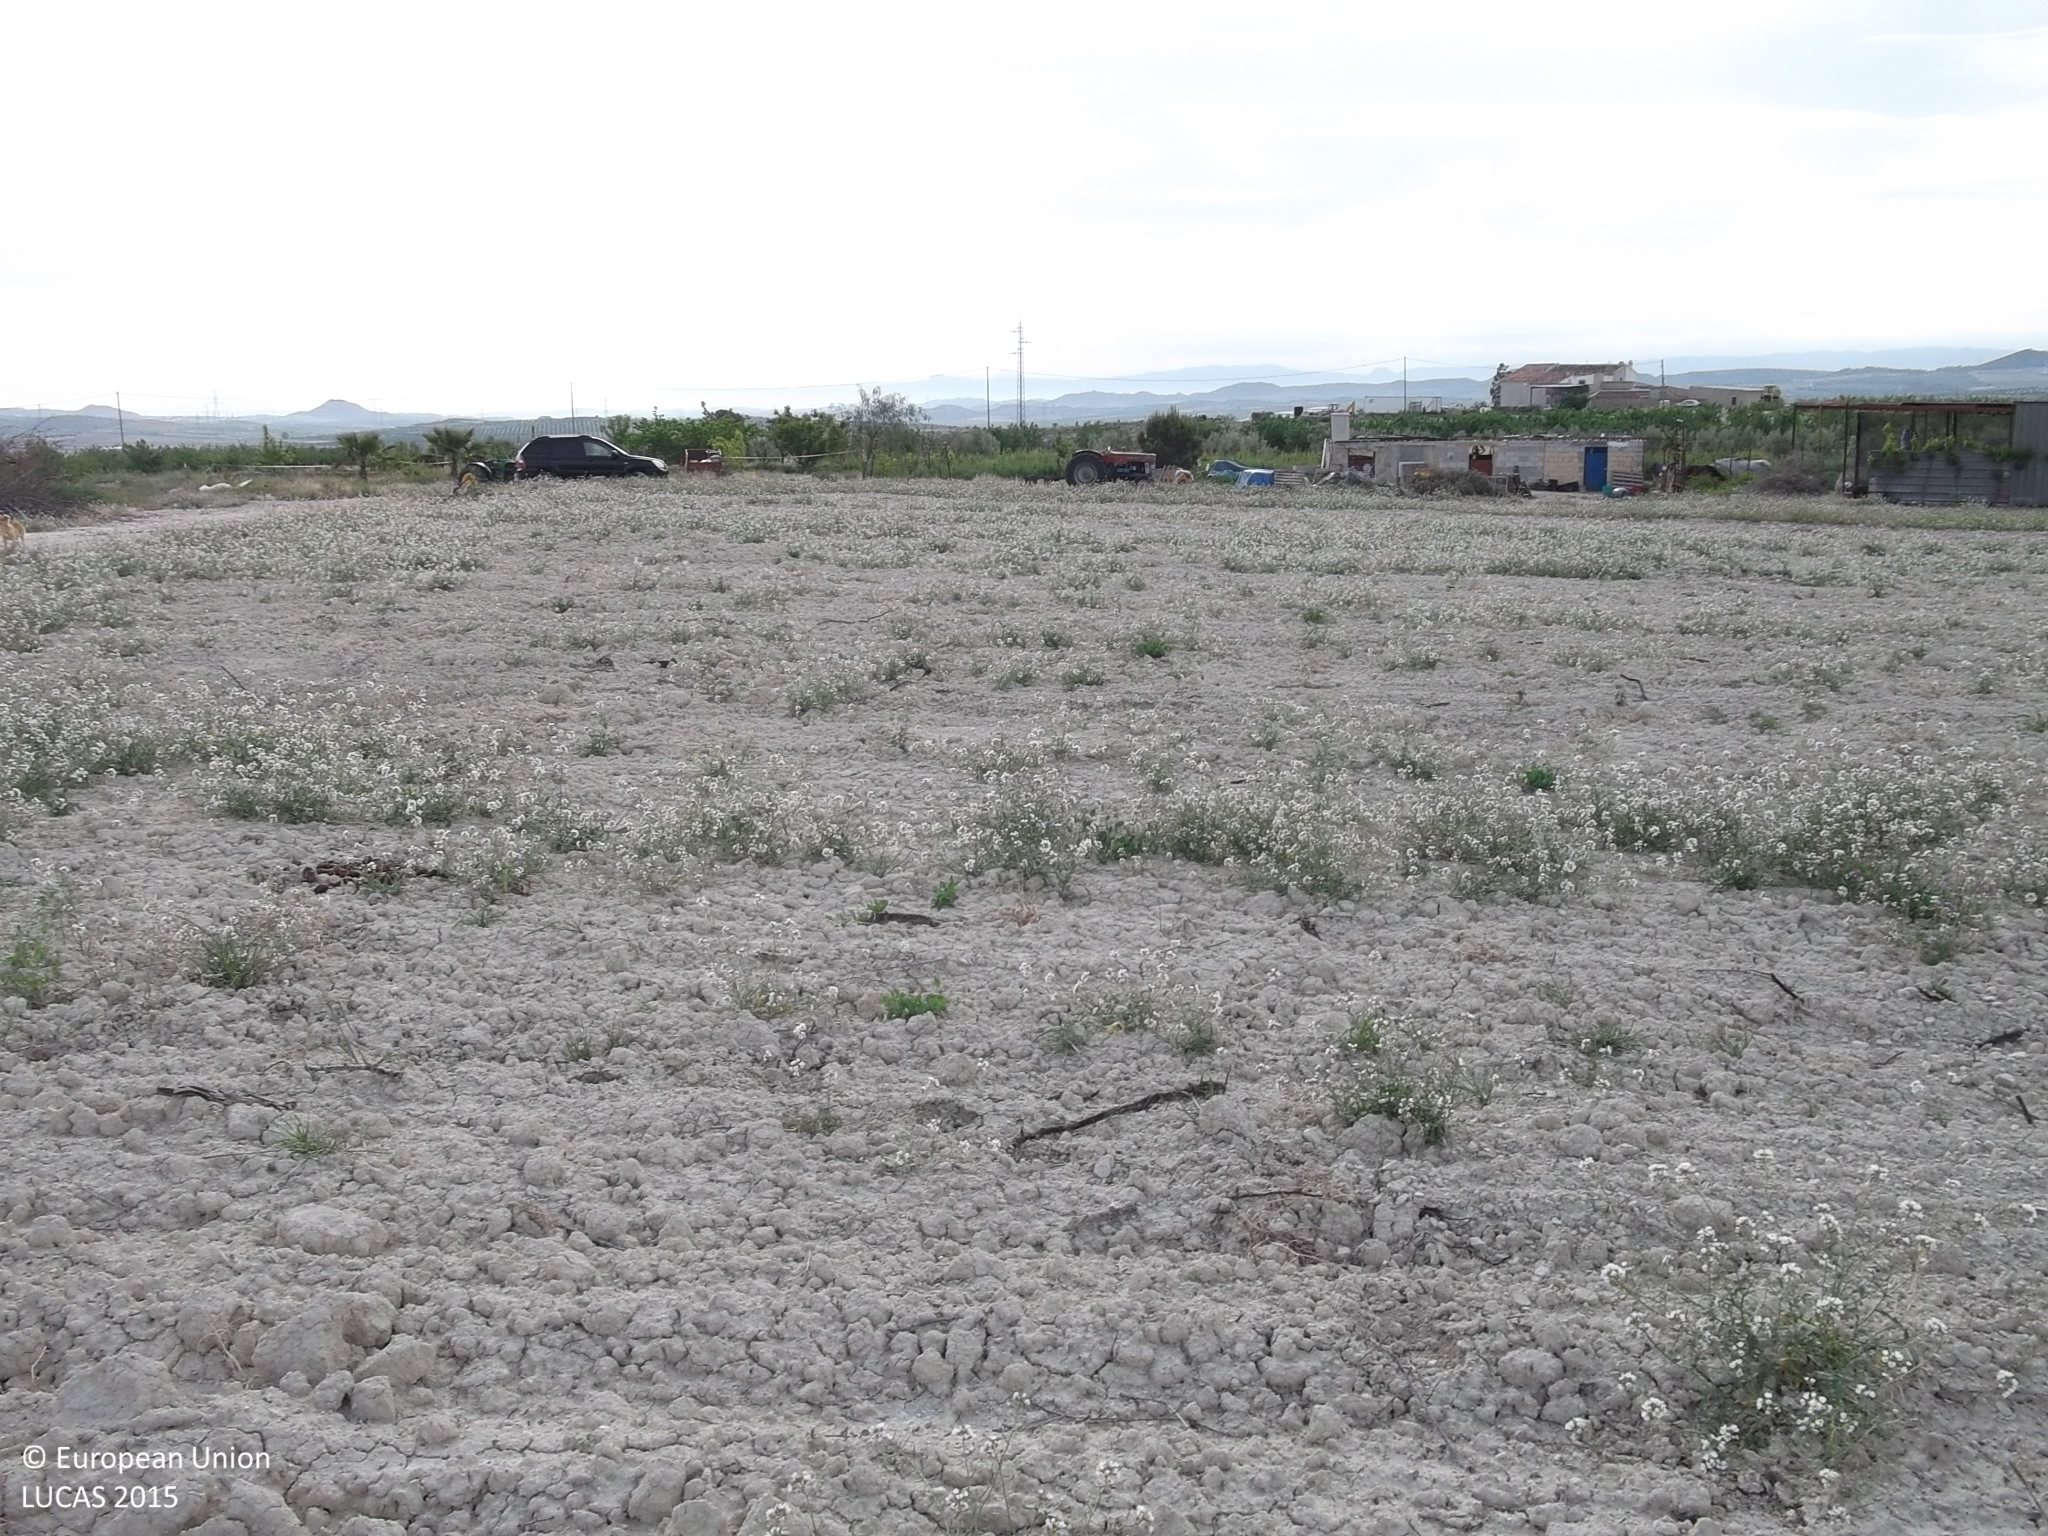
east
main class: Grassland
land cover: Spontaneously vegetated surfaces
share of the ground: 10 - 25 %
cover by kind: consolidated bare surface 80 %, herbaceous plants 20 %
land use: Fallow land
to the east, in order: Spontaneously vegetated surfaces; Tracks; Nuts trees; Other fruit trees and berries; Grass margins; Olive groves; Grass margins; Tracks; Grass margins; Nuts trees
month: April
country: ES
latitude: 37.9865
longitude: -1.4510
